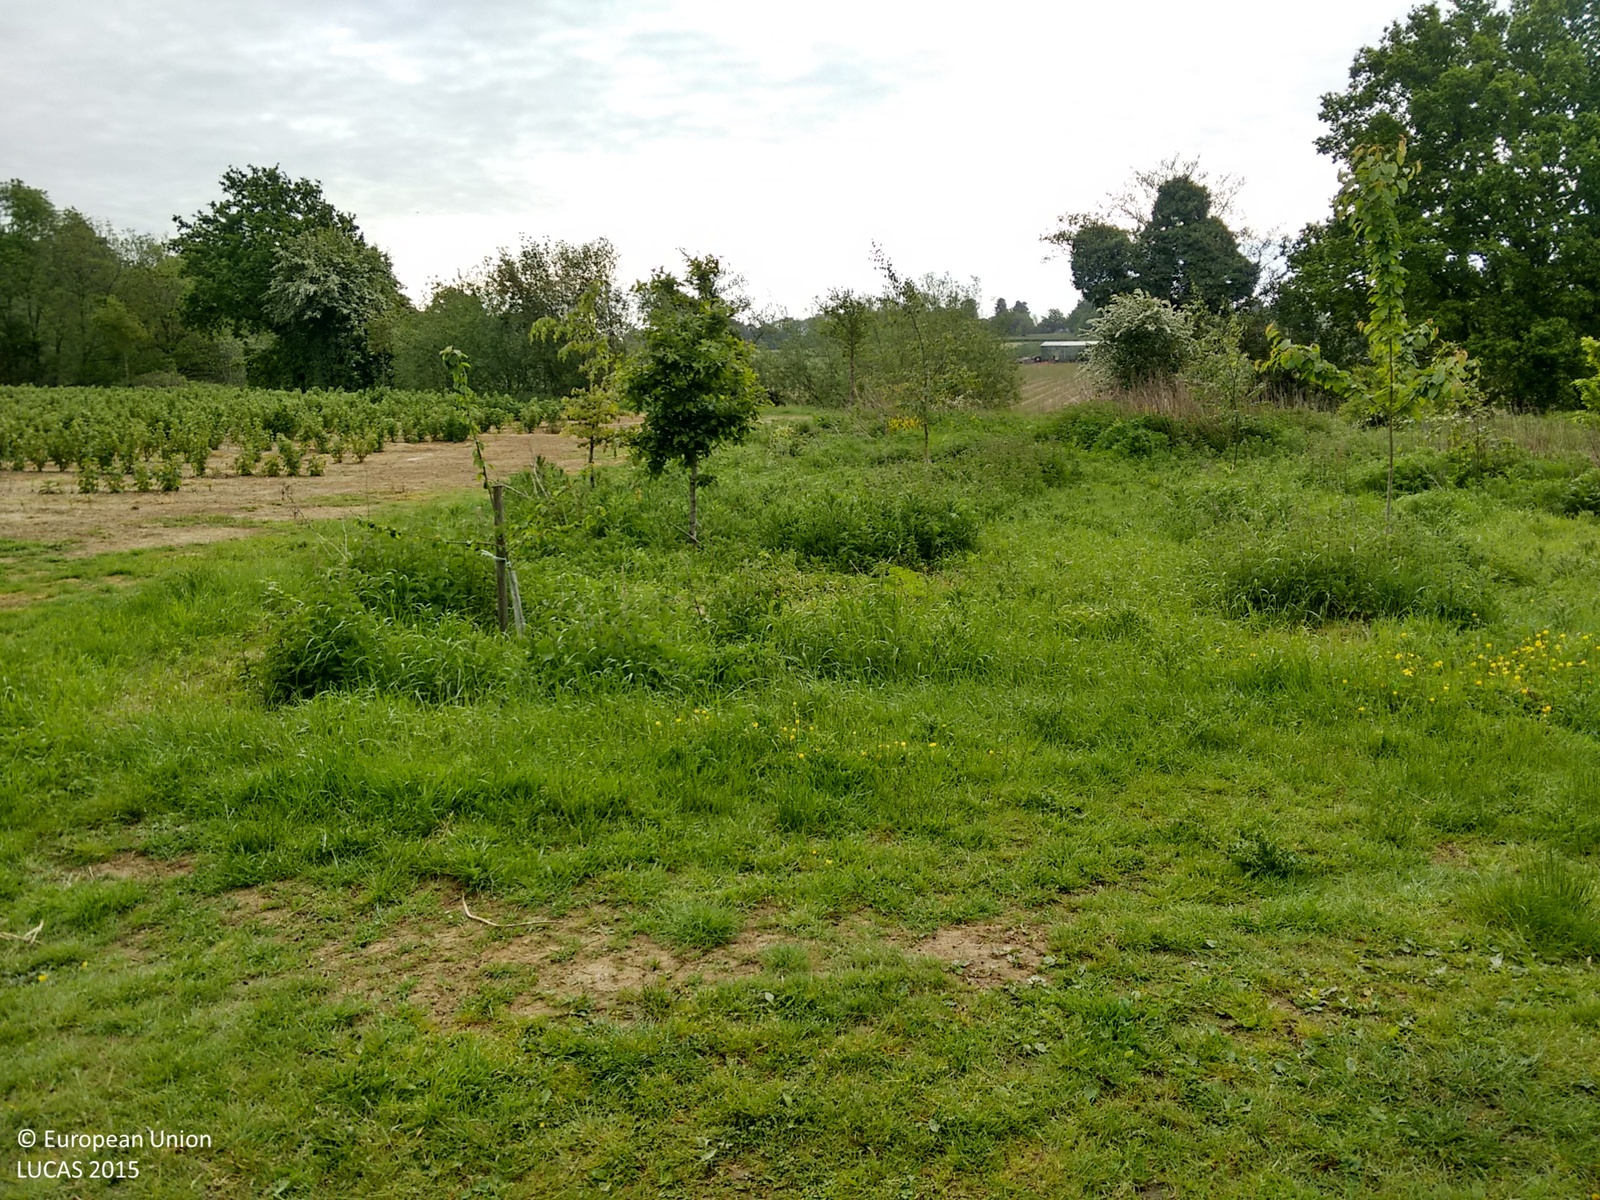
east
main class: Woodland
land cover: Broadleaved woodland
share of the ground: > 75 %
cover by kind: broadleaved forest trees 60 %, shrubs 40 %
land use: Semi-natural and natural areas not in use
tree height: > 5 m
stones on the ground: < 10 %
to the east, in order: Broadleaved woodland; Shruby margins; Tracks; Vineyards; Tracks; Grass margins; Shrubland with sparse tree cover; Inland fresh running water; Shrubland with sparse tree cover; Spontaneously vegetated surfaces; Tracks; Permanent industrial crops; Grassland without tree/shrub cover
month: May
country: GB
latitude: 51.1420
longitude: 0.4666
